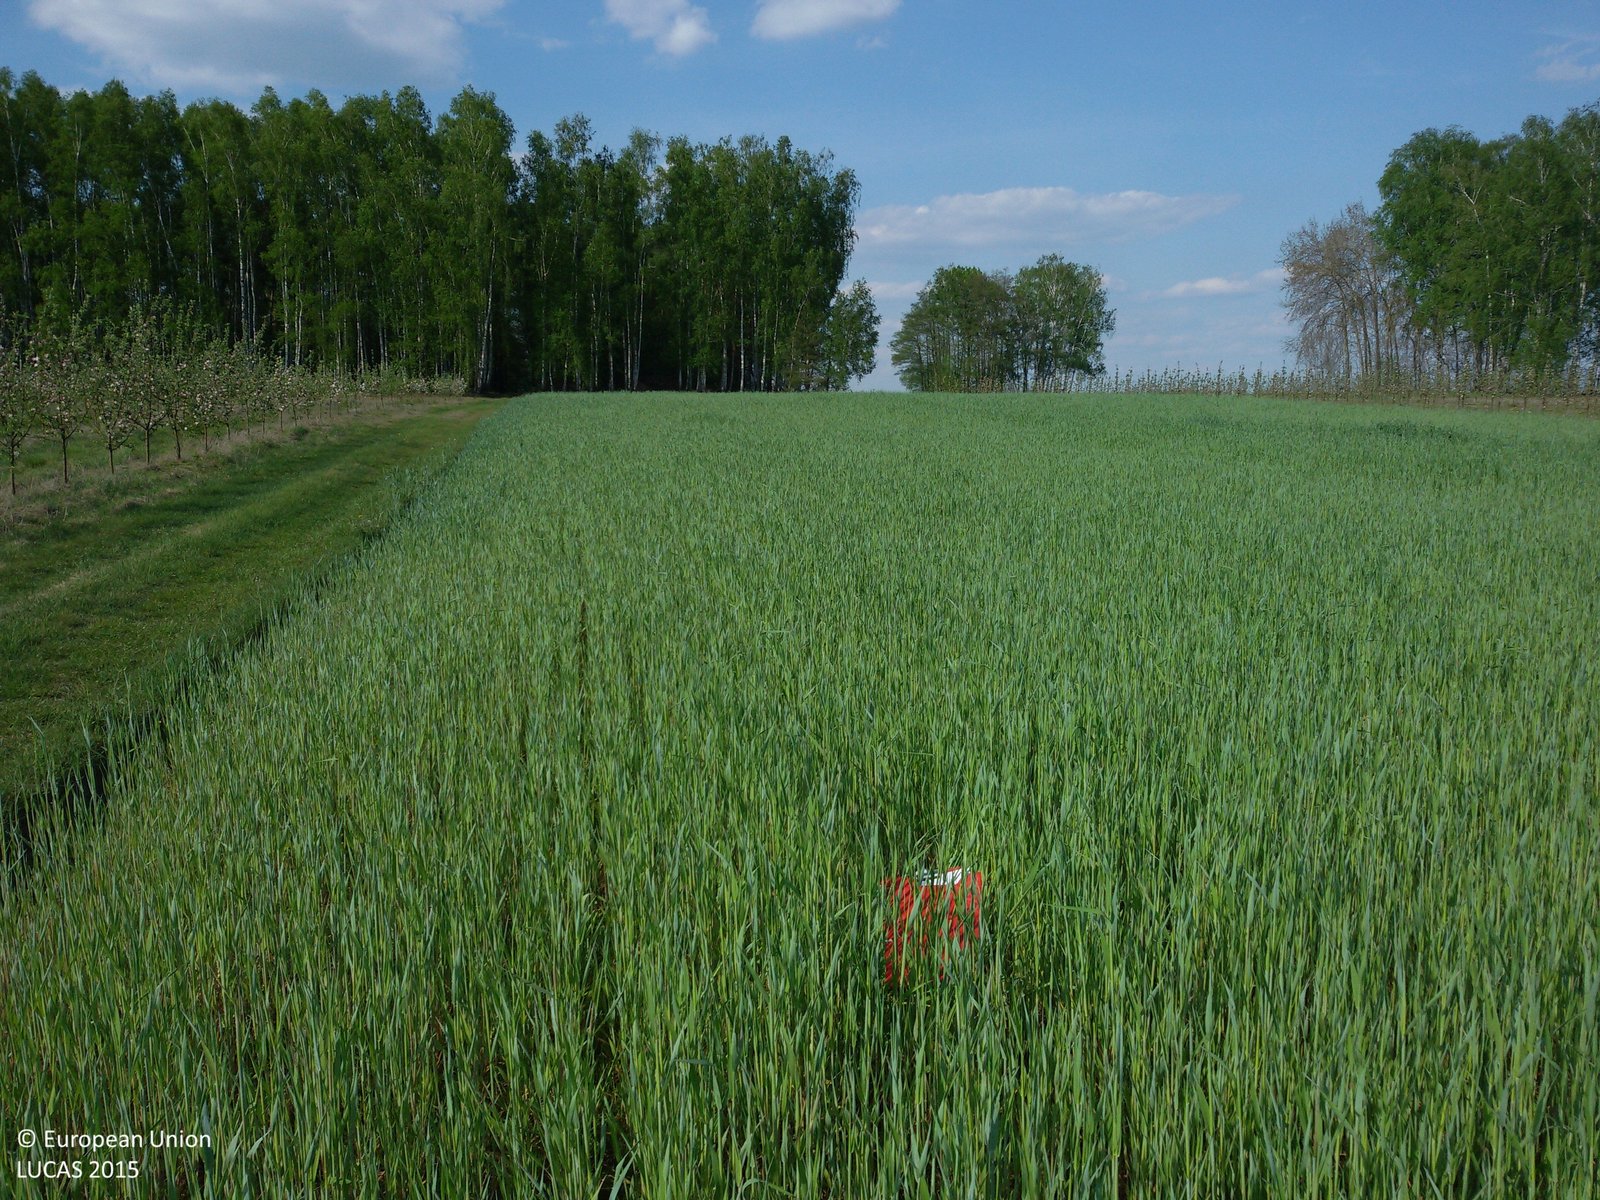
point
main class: Cropland
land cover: Rye
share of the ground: > 75 %
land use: Agriculture (excluding fallow land and kitchen gardens)
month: May
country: PL
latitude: 51.8406
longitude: 21.0615
